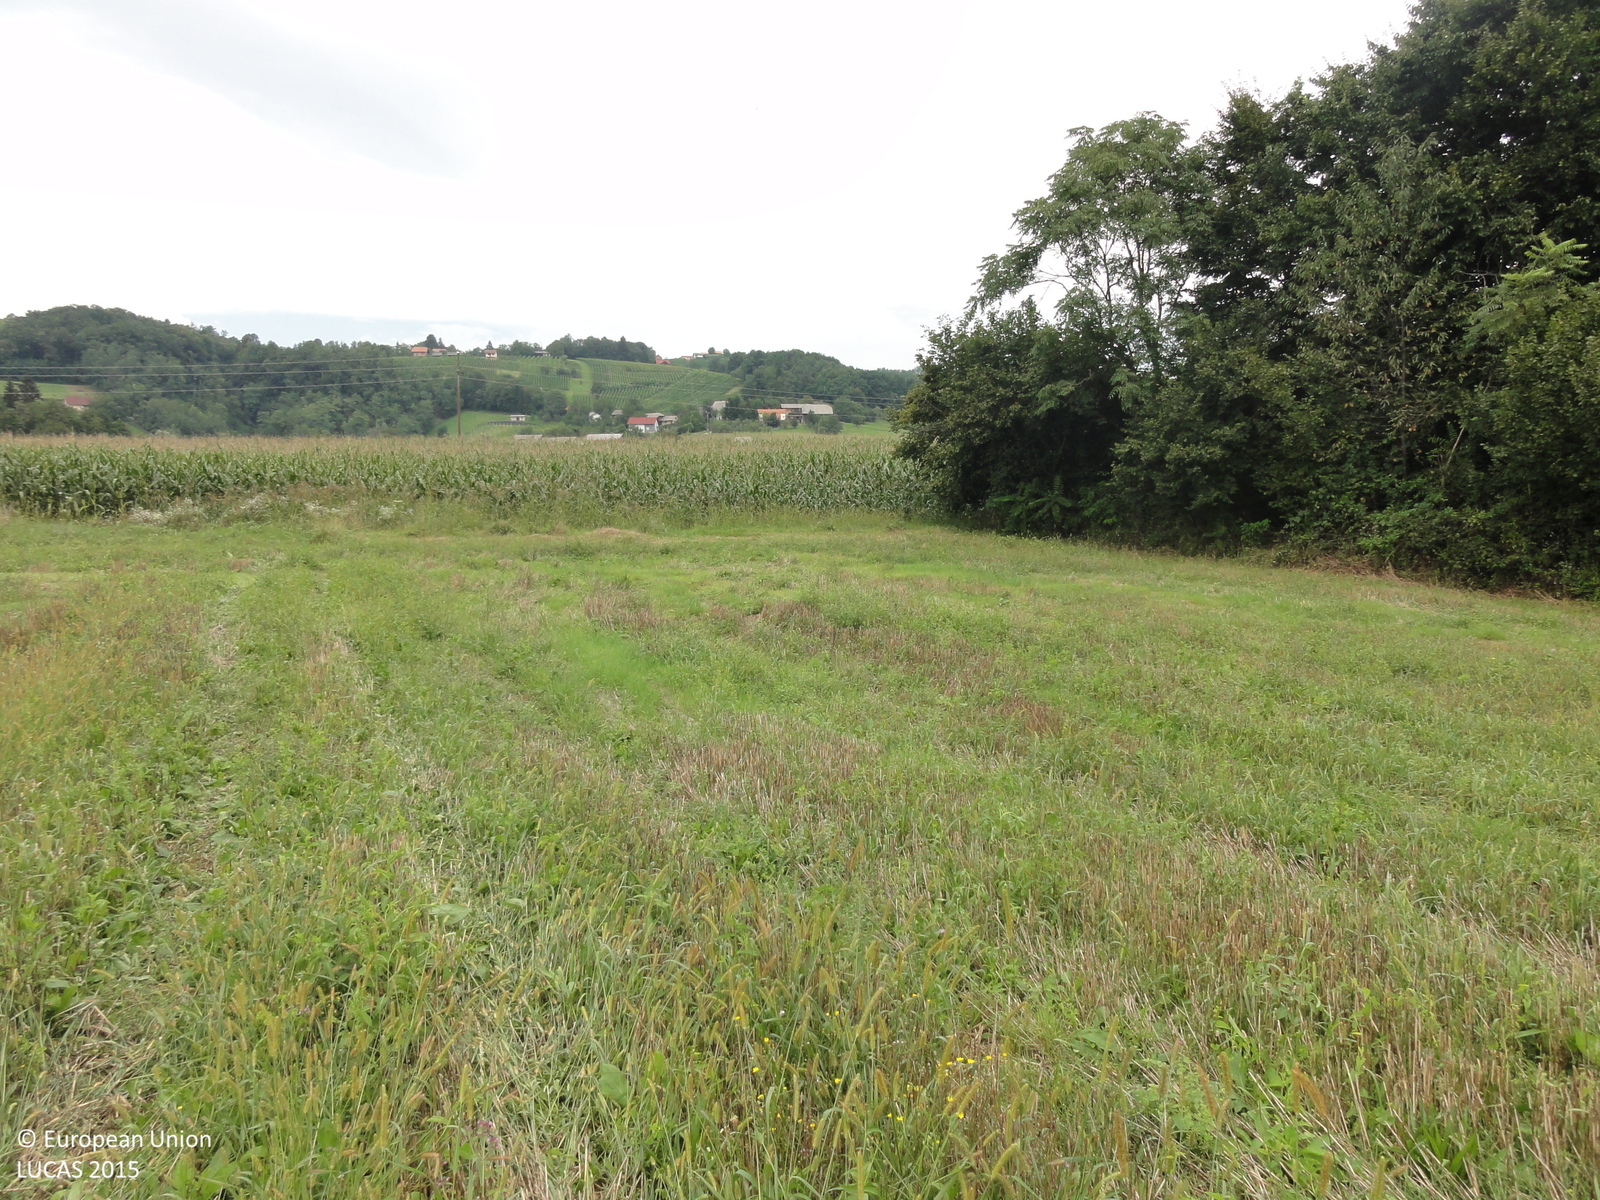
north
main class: Cropland
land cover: Common wheat
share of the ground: < 10 %
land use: Agriculture (excluding fallow land and kitchen gardens)
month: August
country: SI
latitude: 45.9413
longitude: 15.4535
